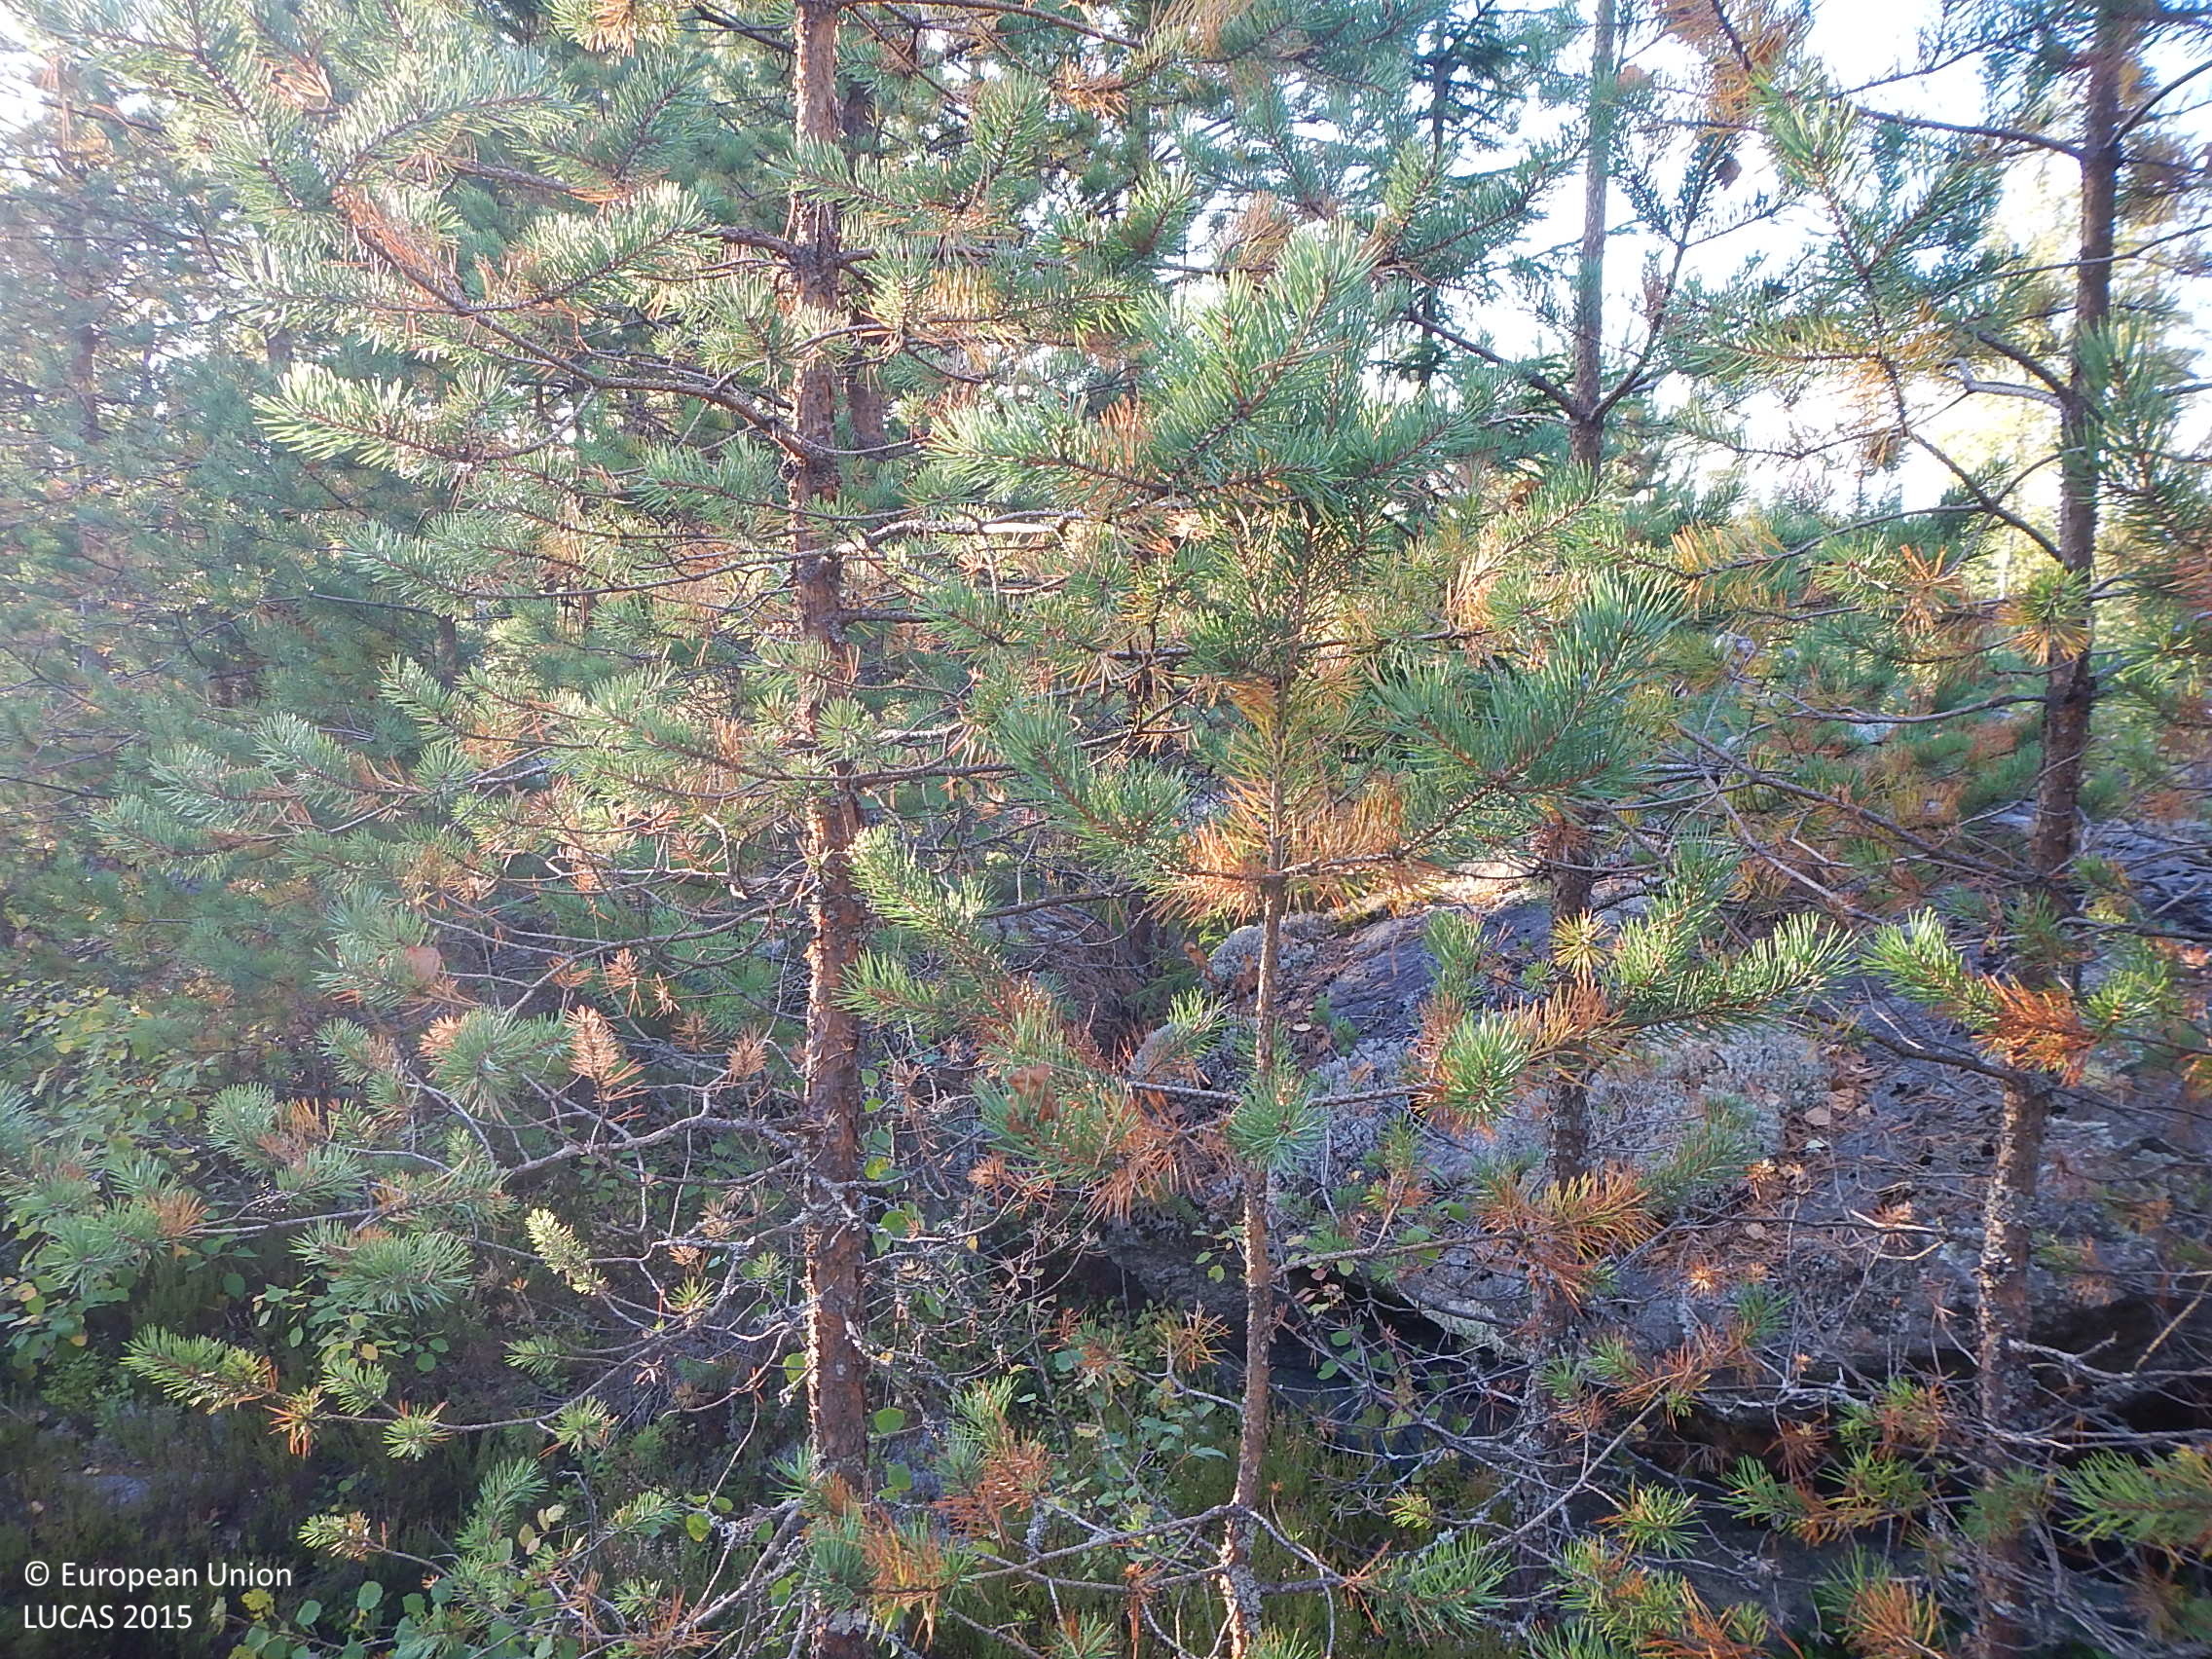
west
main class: Woodland
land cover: Pine dominated coniferous woodland
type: boreal forest
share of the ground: 25 - 50 %
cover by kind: coniferous forest trees 40 %, lichens and mosses 30 %, shrubs 15 %, consolidated bare surface 10 %, broadleaved forest trees 5 %
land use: Forestry
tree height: > 5 m
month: September
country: FI
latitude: 61.5511
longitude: 22.1580
